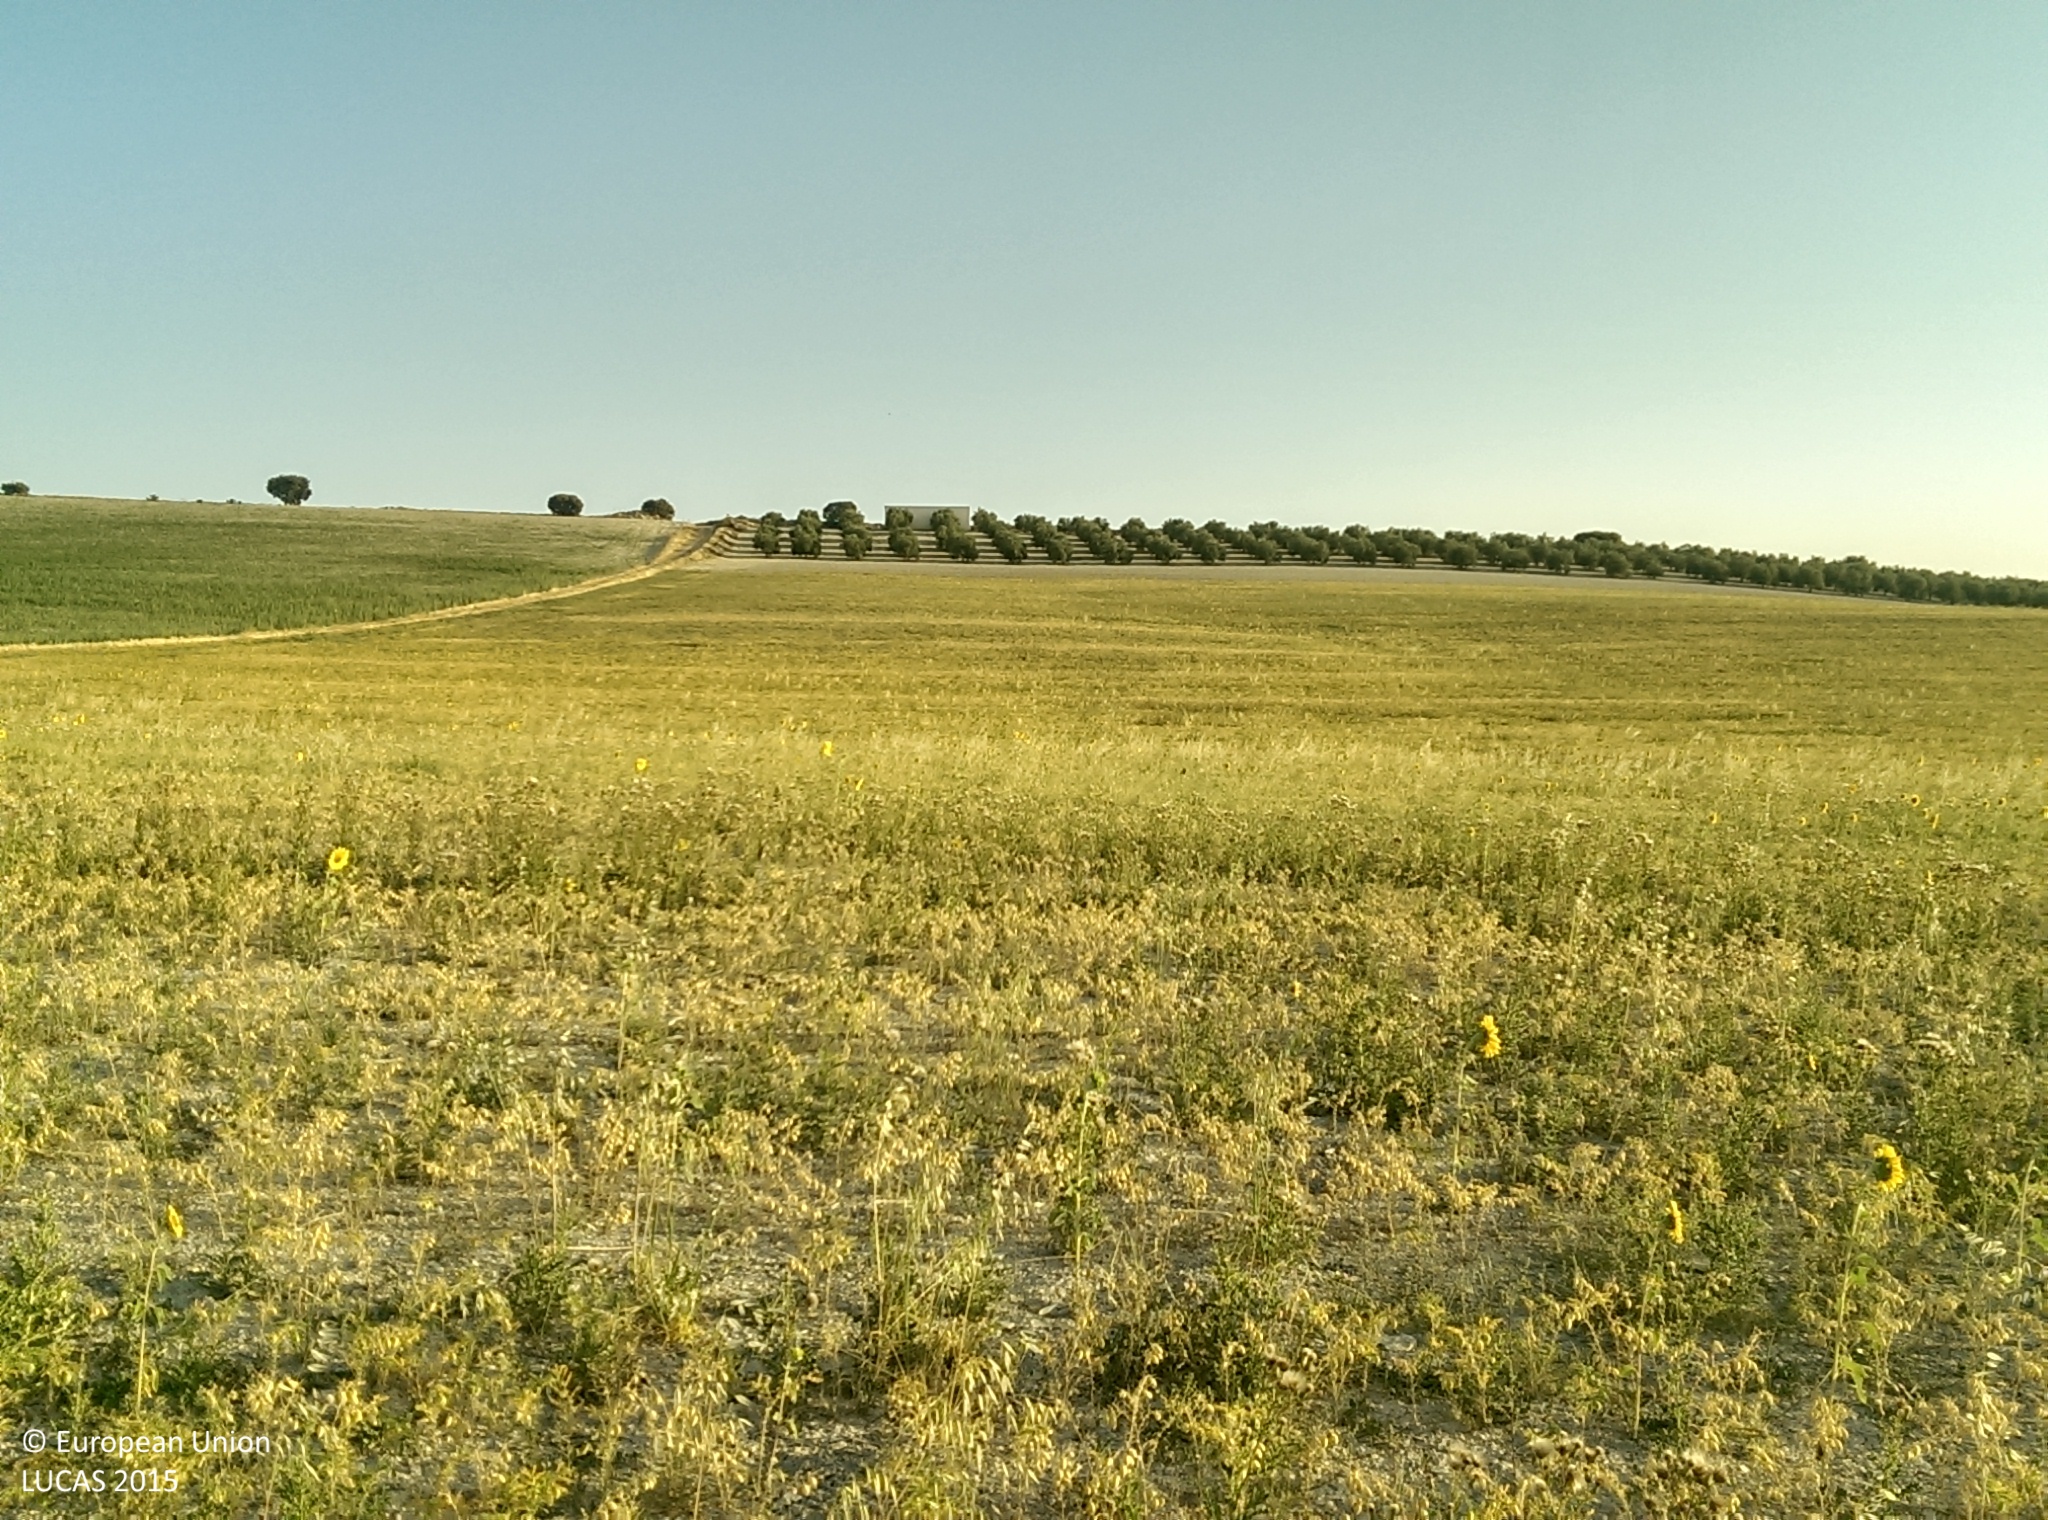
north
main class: Cropland
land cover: Dry pulses
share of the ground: > 75 %
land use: Agriculture (excluding fallow land and kitchen gardens)
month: July
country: ES
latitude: 37.5053
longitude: -3.3063
